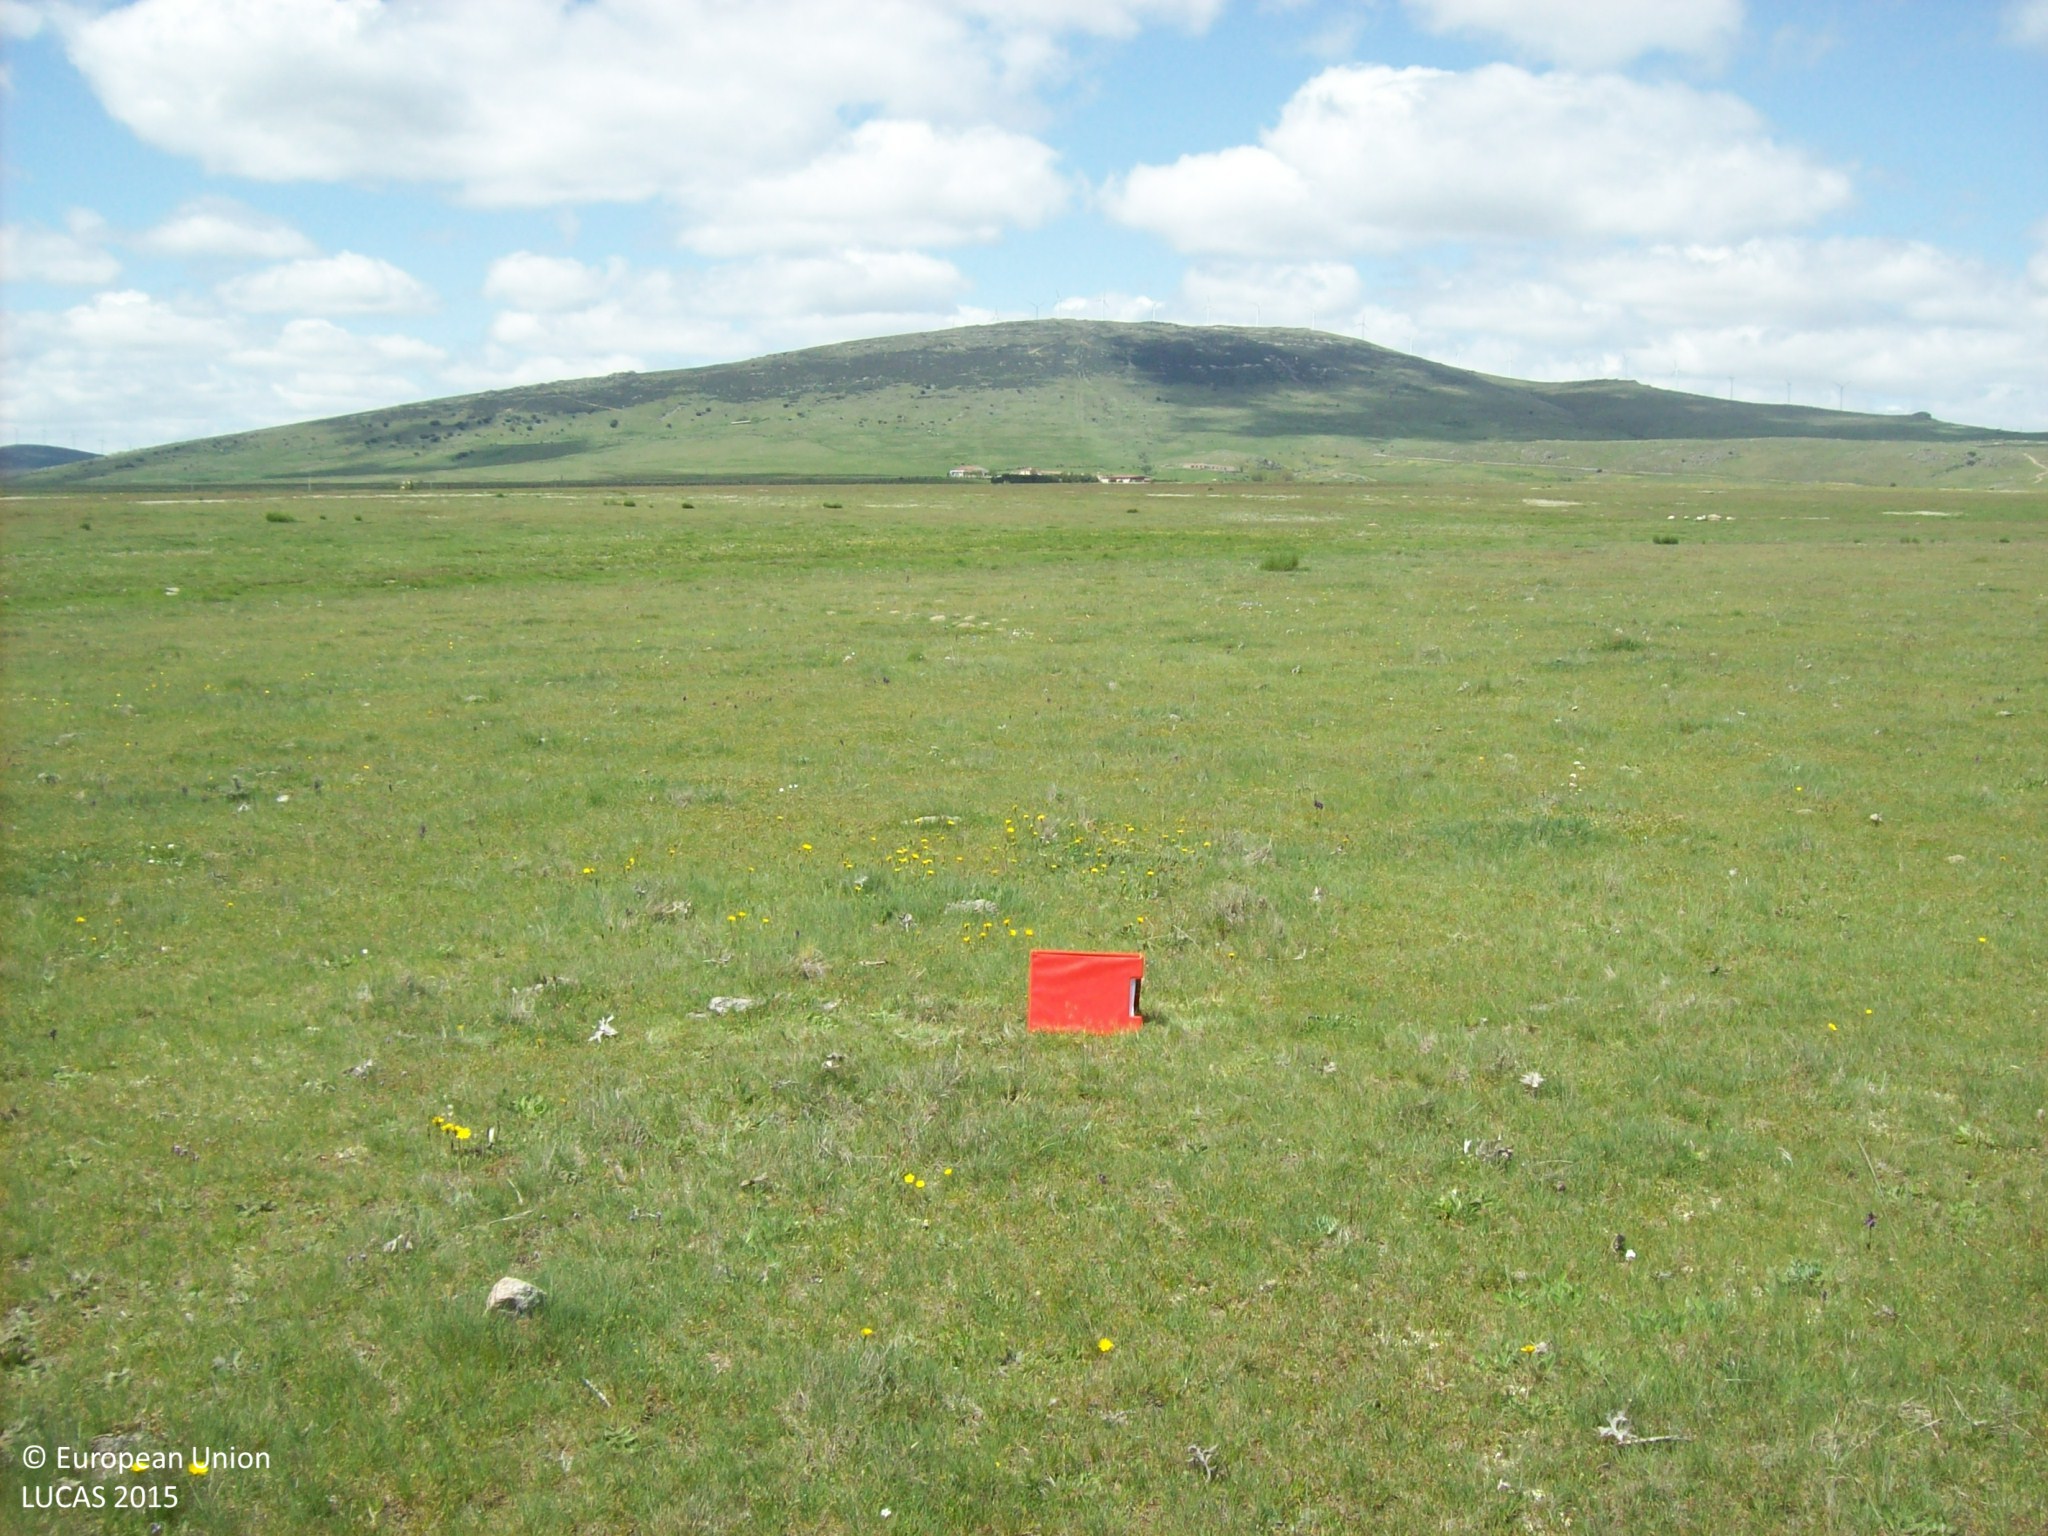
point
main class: Grassland
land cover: Grassland without tree/shrub cover
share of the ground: > 75 %
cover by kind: herbaceous plants 100 %
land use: Agriculture (excluding fallow land and kitchen gardens)
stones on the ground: < 10 %
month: May
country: ES
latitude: 40.6804
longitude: -4.4268
